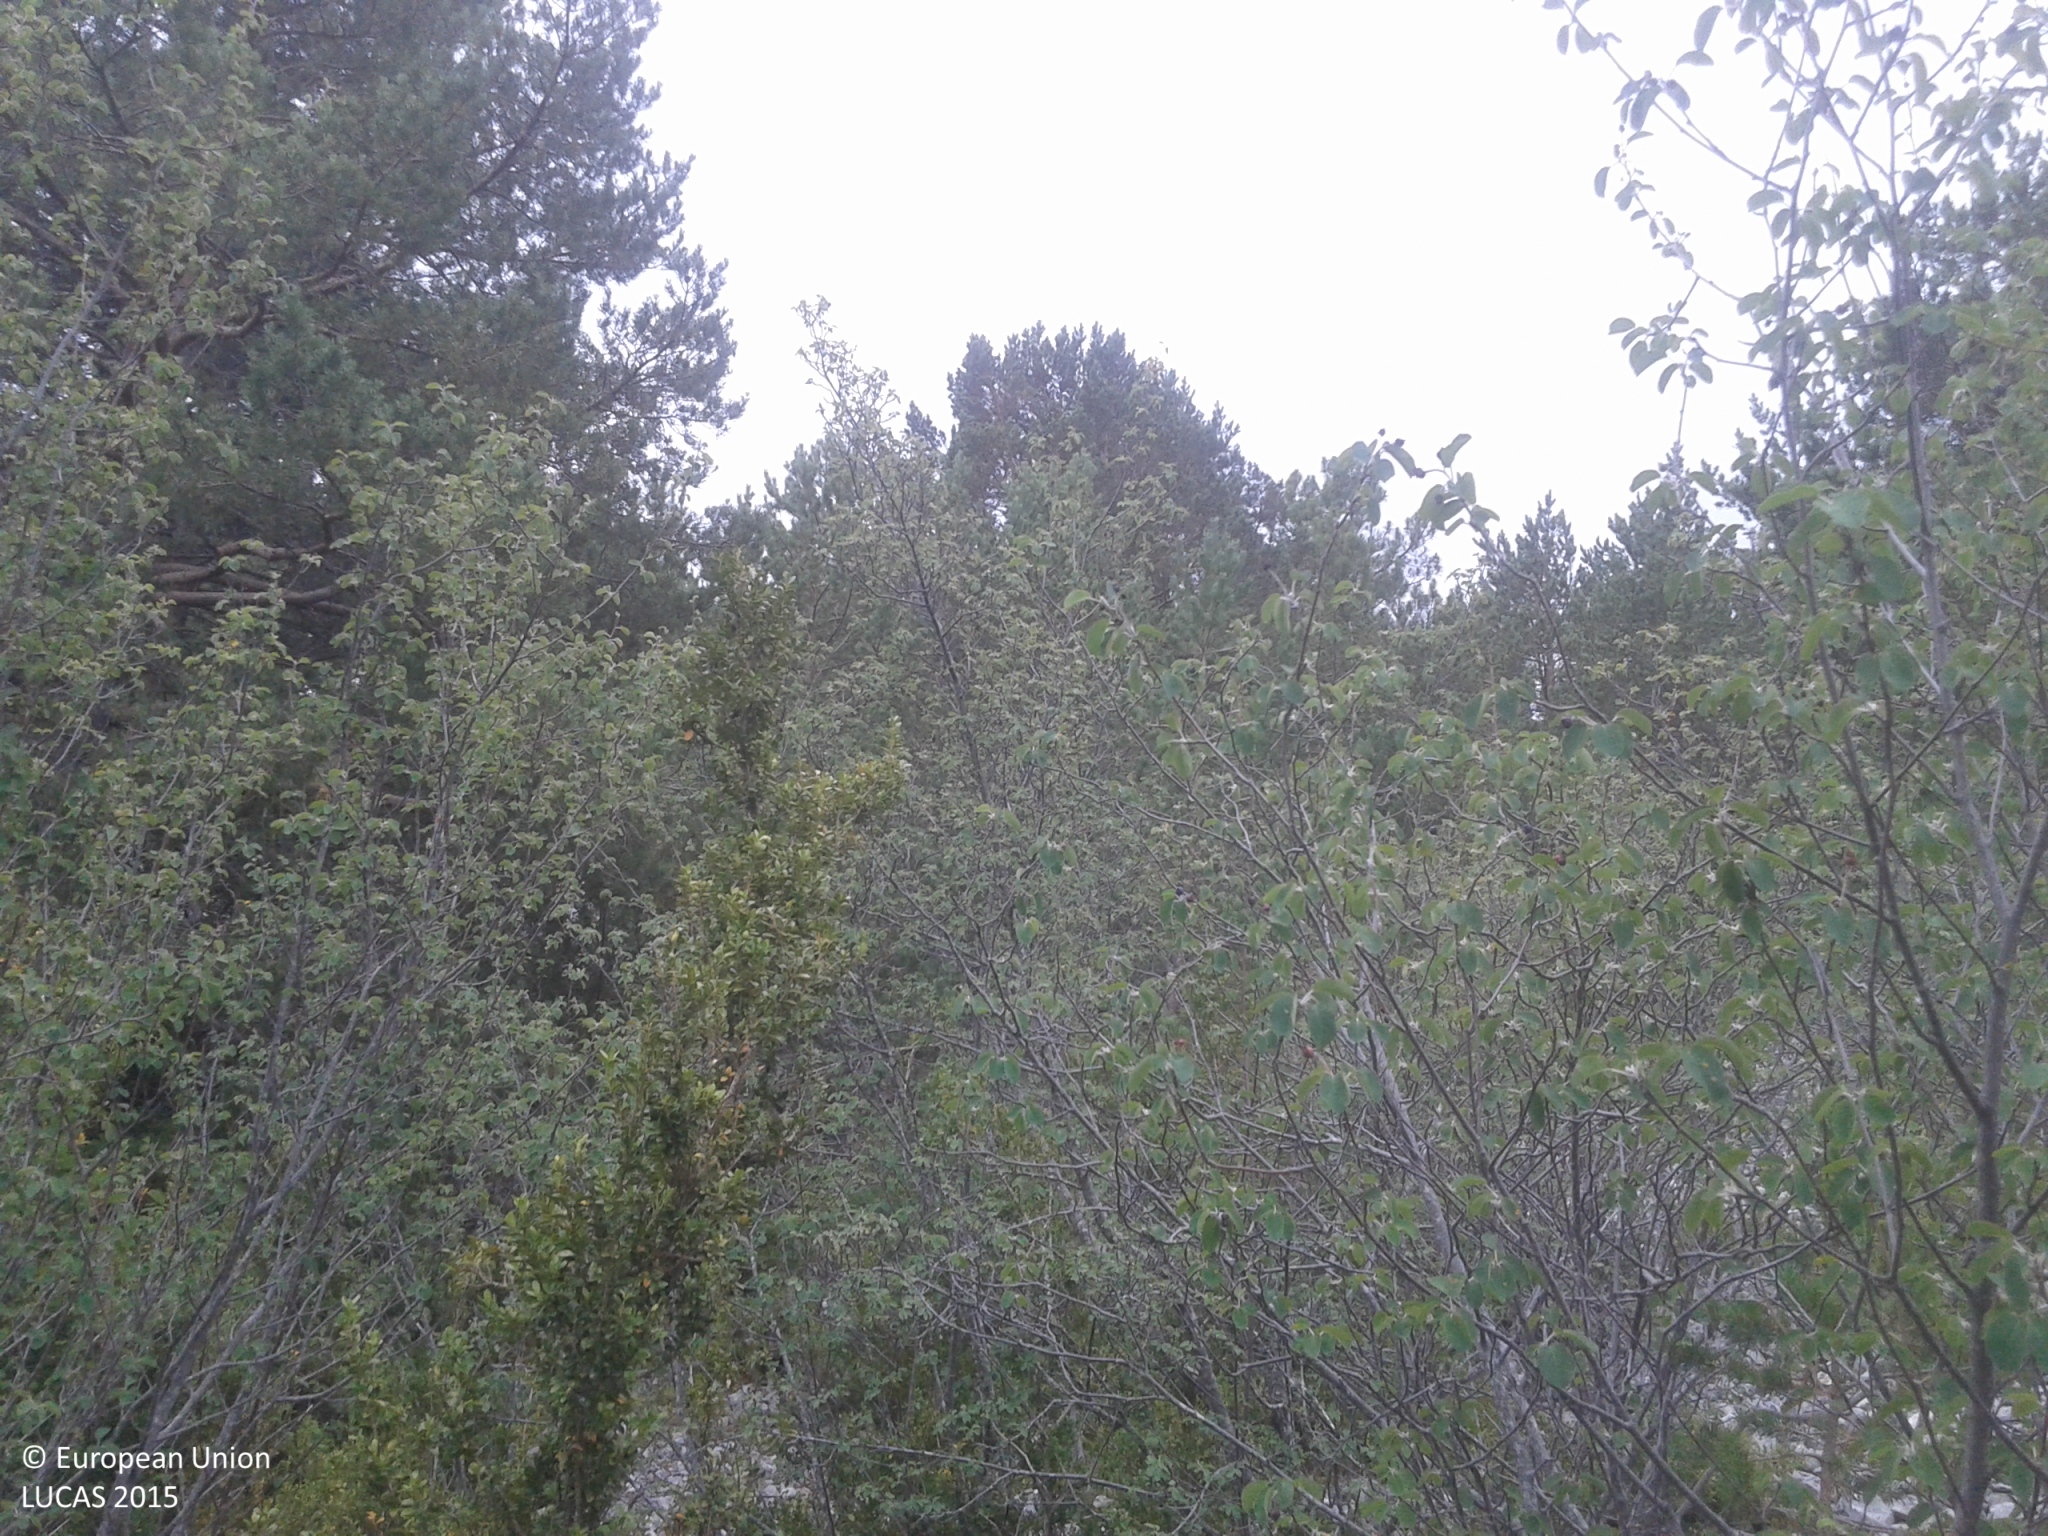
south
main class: Woodland
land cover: Pine dominated coniferous woodland
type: alpine coniferous forest
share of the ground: 25 - 50 %
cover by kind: consolidated bare surface 40 %, shrubs 30 %, coniferous forest trees 25 %, herbaceous plants 5 %
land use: Semi-natural and natural areas not in use
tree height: > 5 m
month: July
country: ES
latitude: 42.1753
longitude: 1.5736
